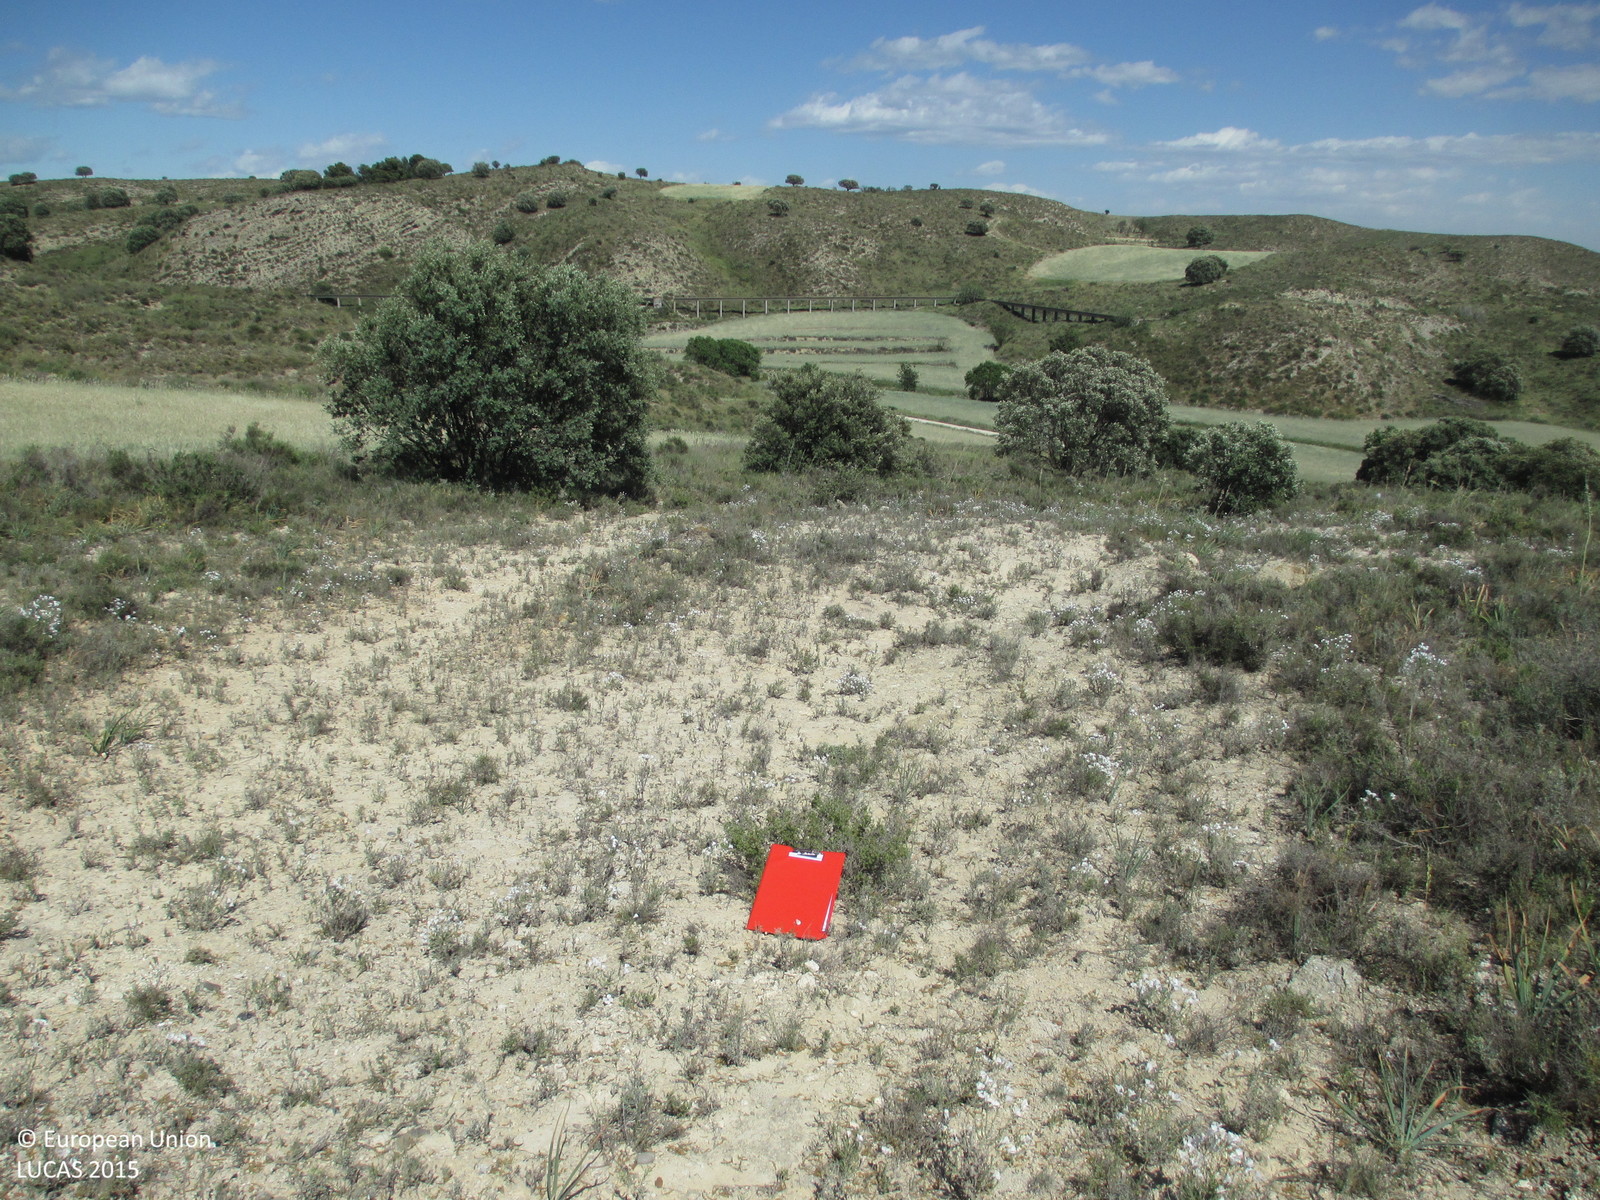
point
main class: Shrubland
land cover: Shrubland with sparse tree cover
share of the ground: > 75 %
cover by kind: shrubs 85 %, broadleaved forest trees 5 %, herbaceous plants 5 %, unconsolidated bare surface 5 %
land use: Semi-natural and natural areas not in use
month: May
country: ES
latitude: 41.9857
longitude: 0.0966
